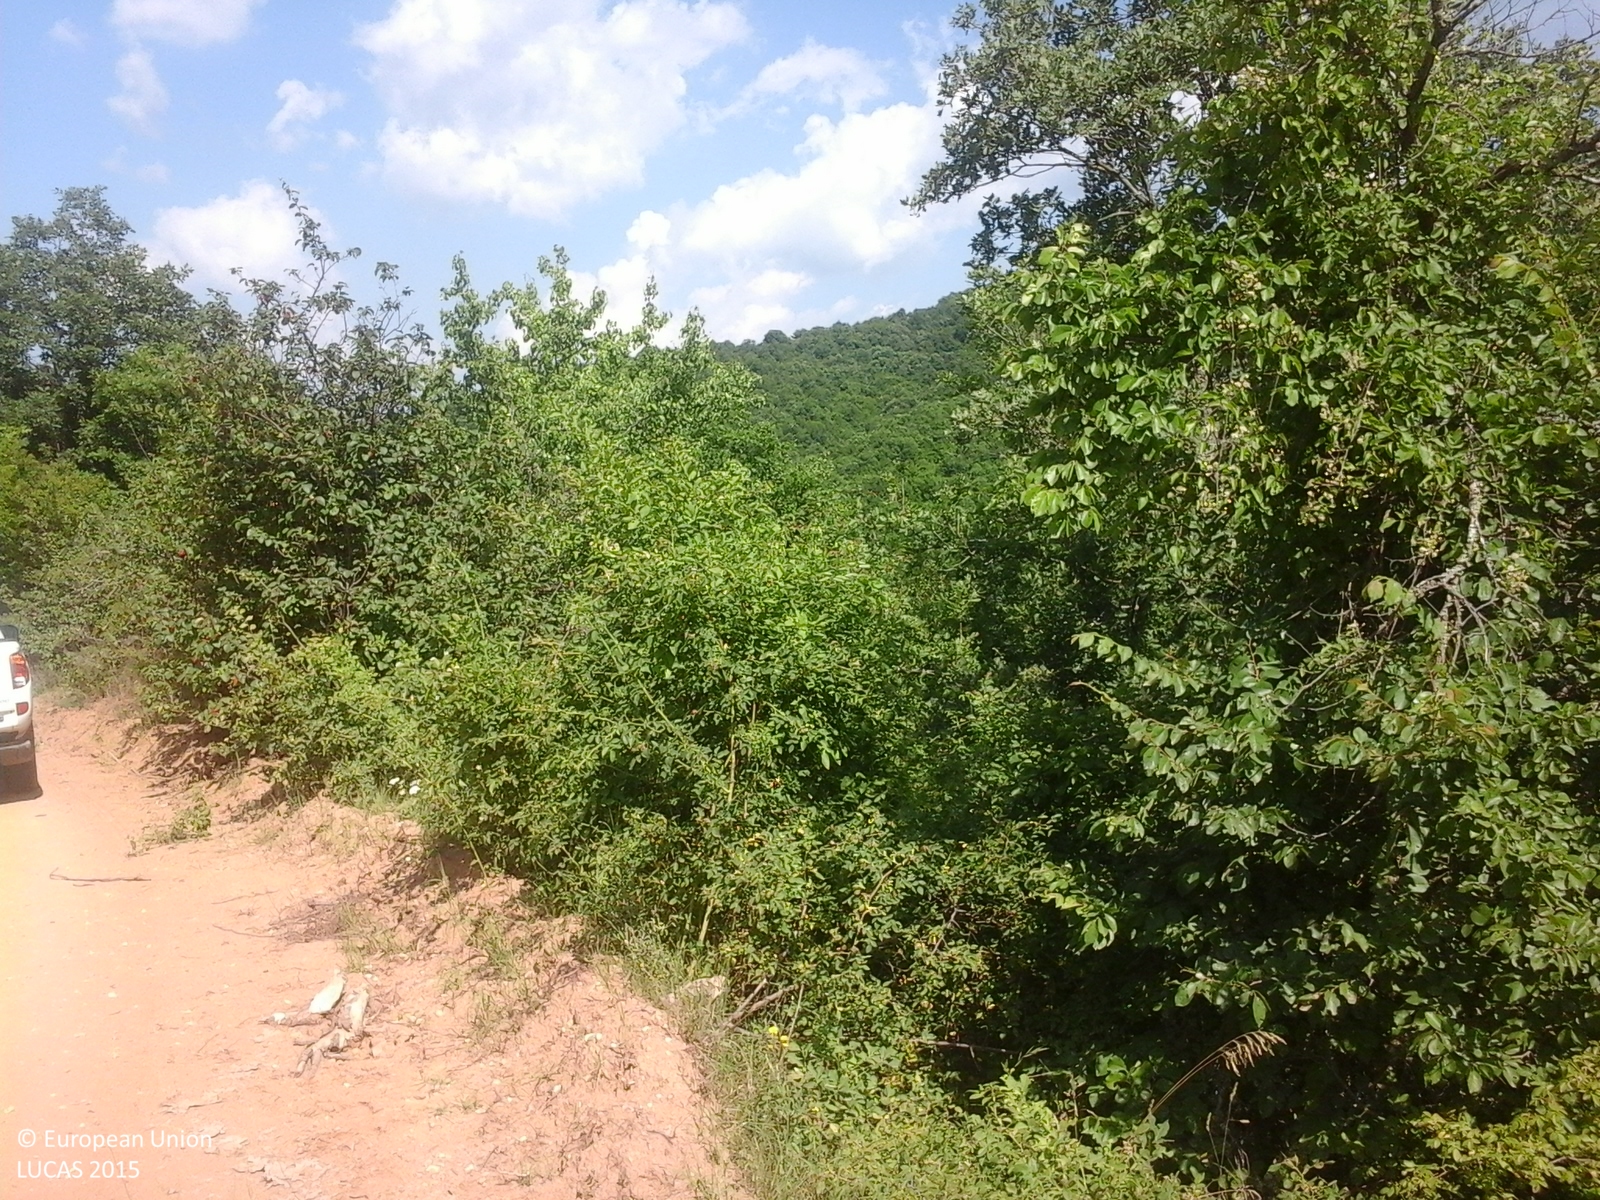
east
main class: Woodland
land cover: Broadleaved woodland
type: mesophytic deciduous forest
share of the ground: > 75 %
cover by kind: broadleaved forest trees 100 %
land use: Forestry
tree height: > 5 m
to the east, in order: Broadleaved woodland
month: June
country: GR
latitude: 40.8838
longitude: 23.2462
